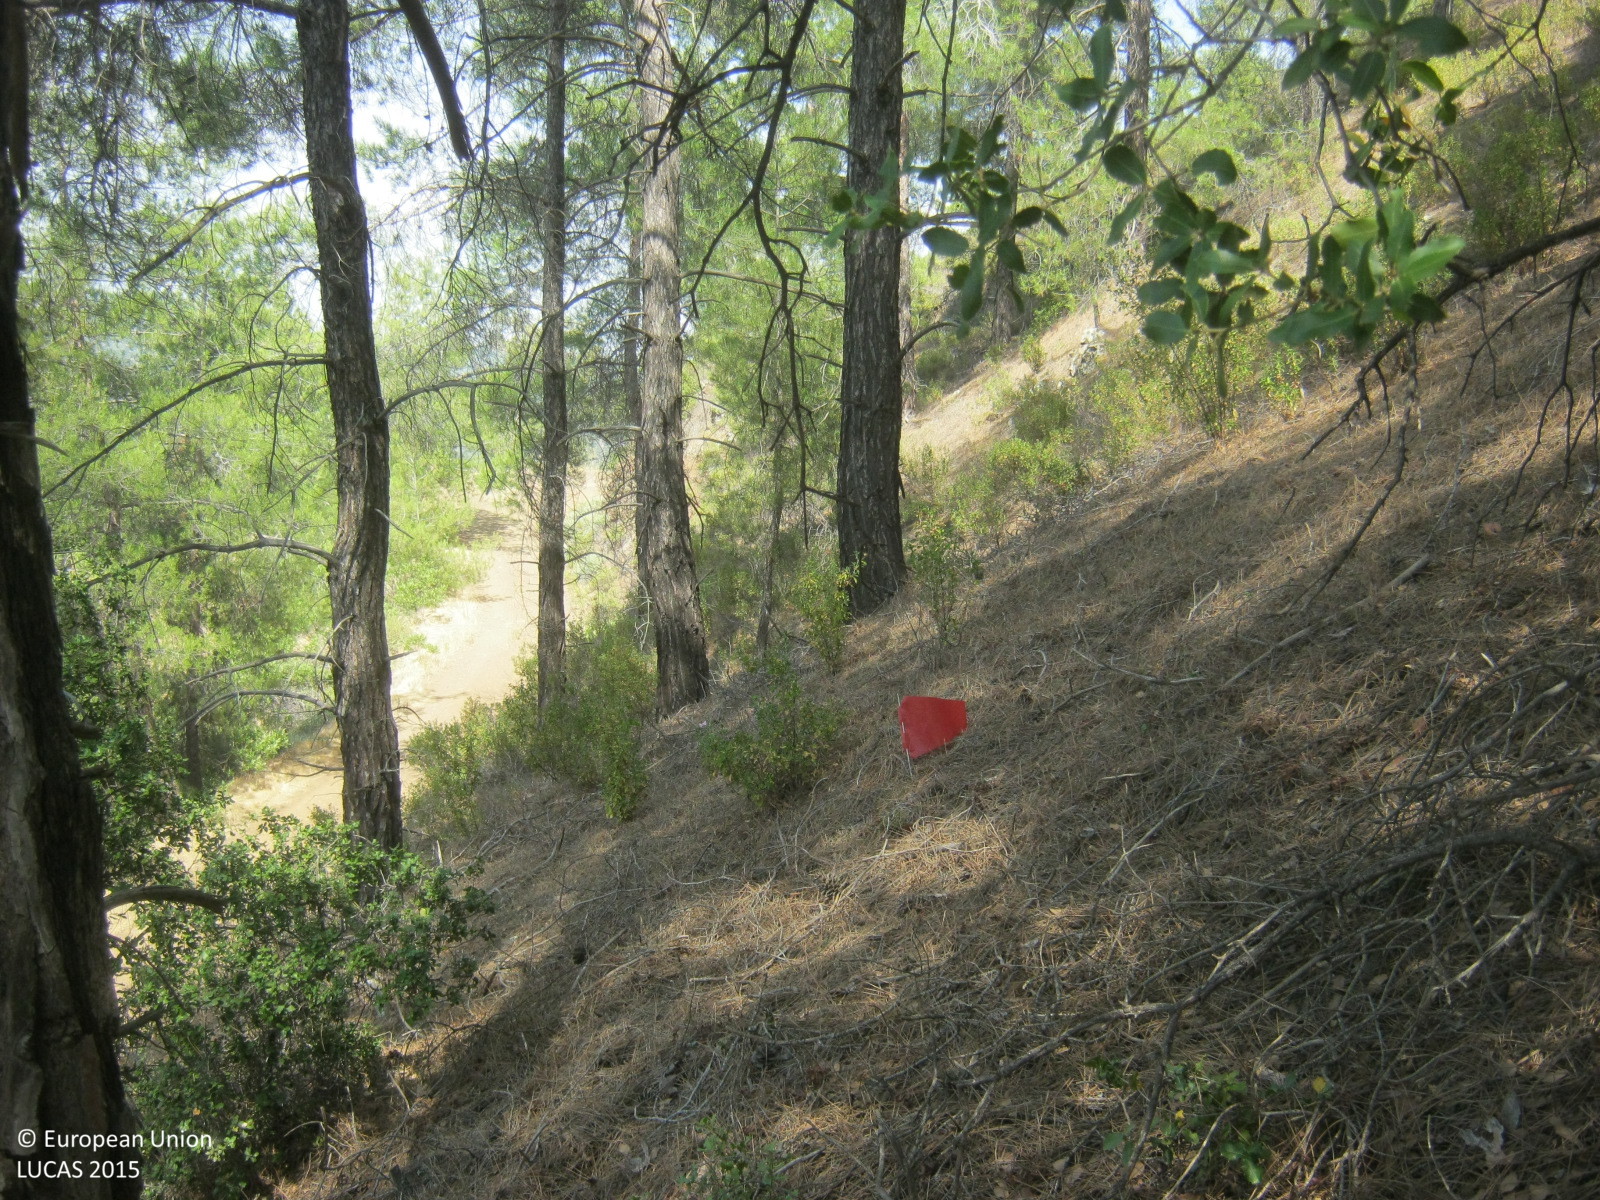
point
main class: Woodland
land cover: Pine dominated coniferous woodland
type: coniferous forest of the mediterranean region
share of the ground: > 75 %
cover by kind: coniferous forest trees 85 %, shrubs 10 %, unconsolidated bare surface 5 %
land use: Forestry
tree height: > 5 m
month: June
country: CY
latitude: 35.0022
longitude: 33.0658
